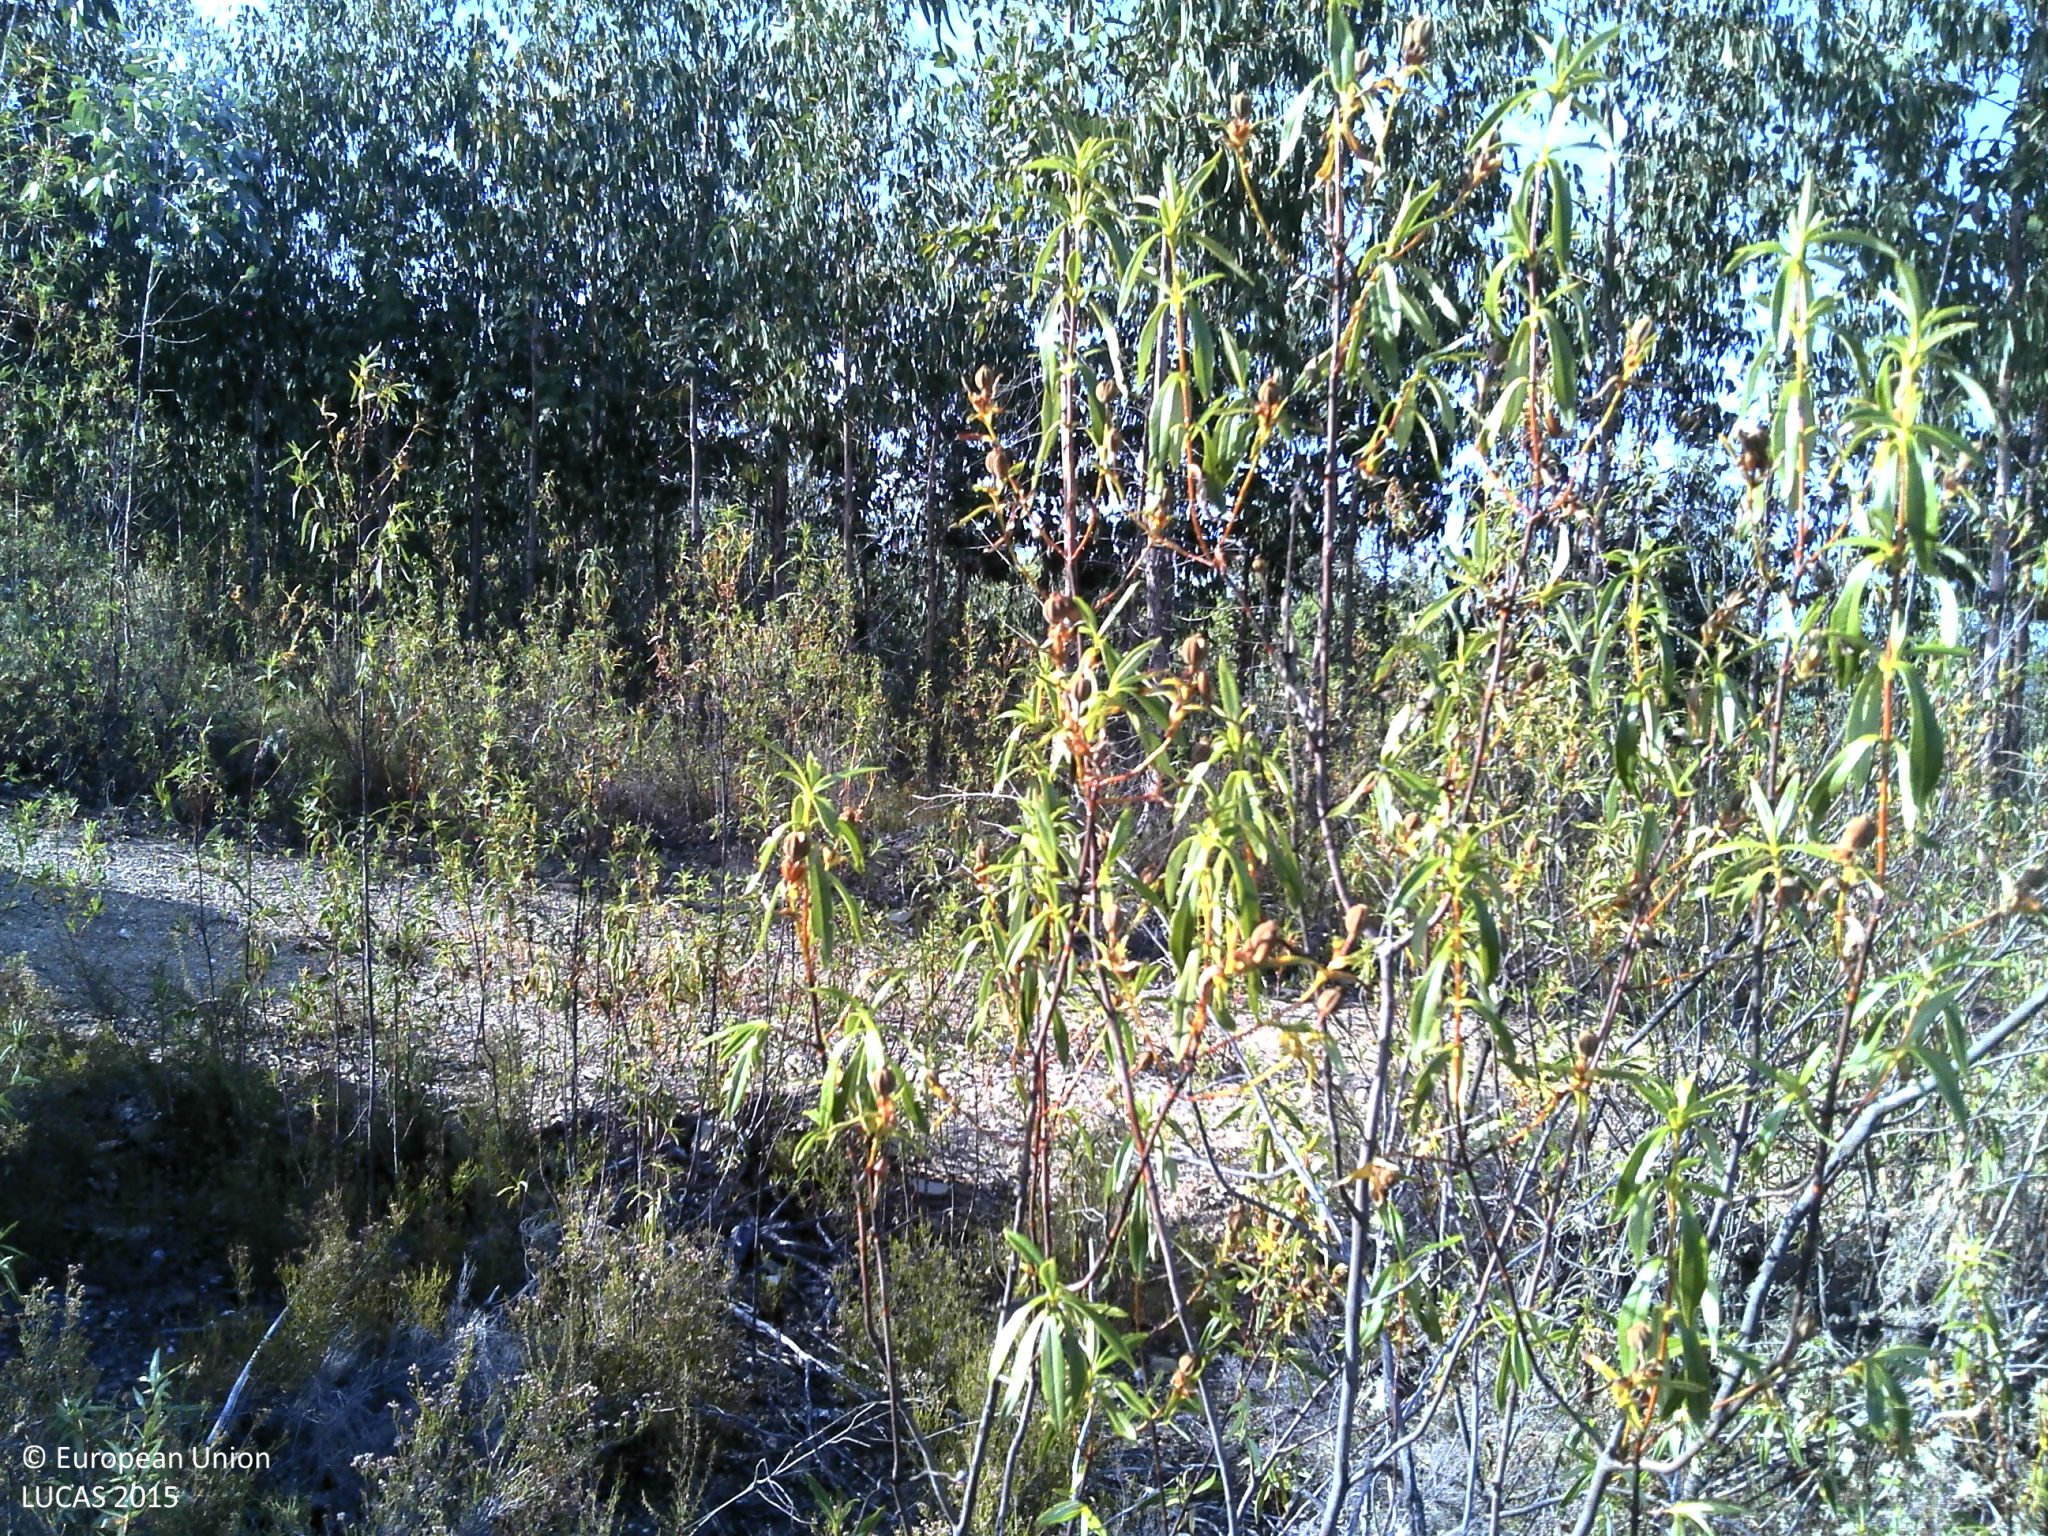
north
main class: Woodland
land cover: Pine dominated coniferous woodland
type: coniferous forest of the mediterranean region
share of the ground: < 10 %
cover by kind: shrubs 90 %, coniferous forest trees 10 %
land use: Forestry
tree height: < 5 m
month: July
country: PT
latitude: 39.7322
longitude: -7.8052
